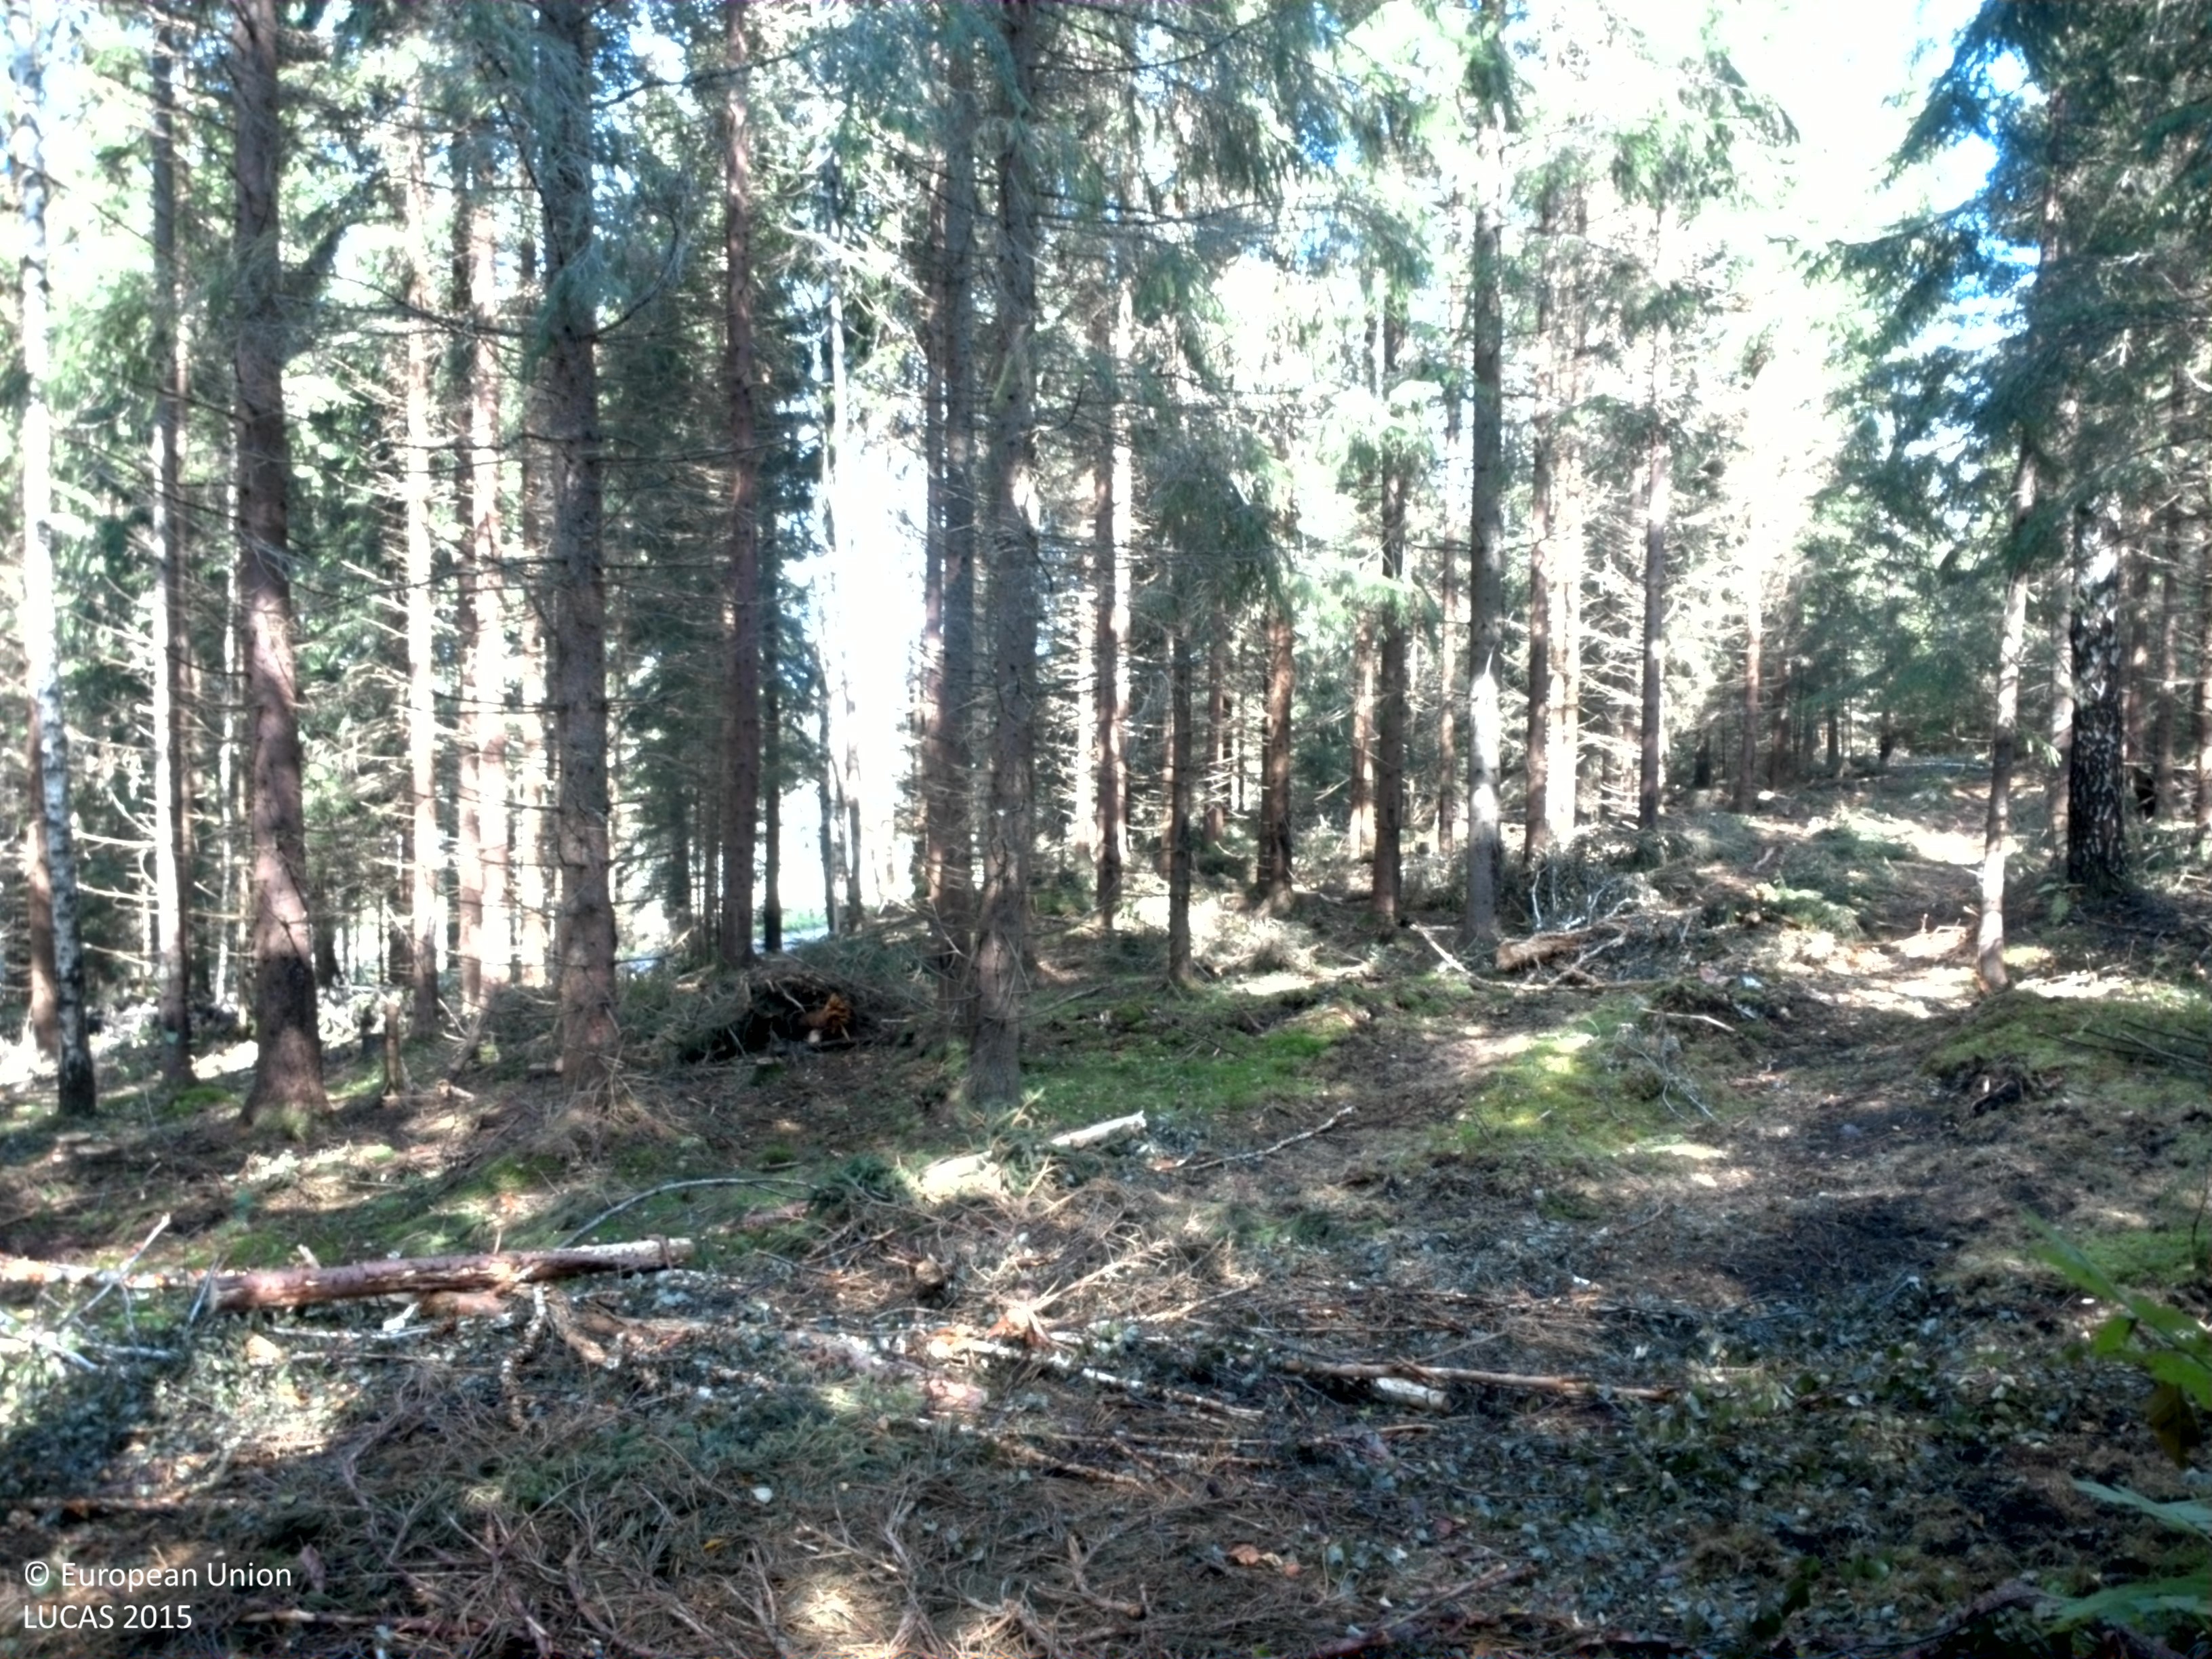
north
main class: Woodland
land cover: Spruce dominated coniferous woodland
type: boreal forest
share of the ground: 50 - 75 %
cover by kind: coniferous forest trees 65 %, lichens and mosses 25 %, shrubs 5 %, herbaceous plants 5 %
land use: Forestry
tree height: > 5 m
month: August
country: SE
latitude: 59.6699
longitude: 13.4536
